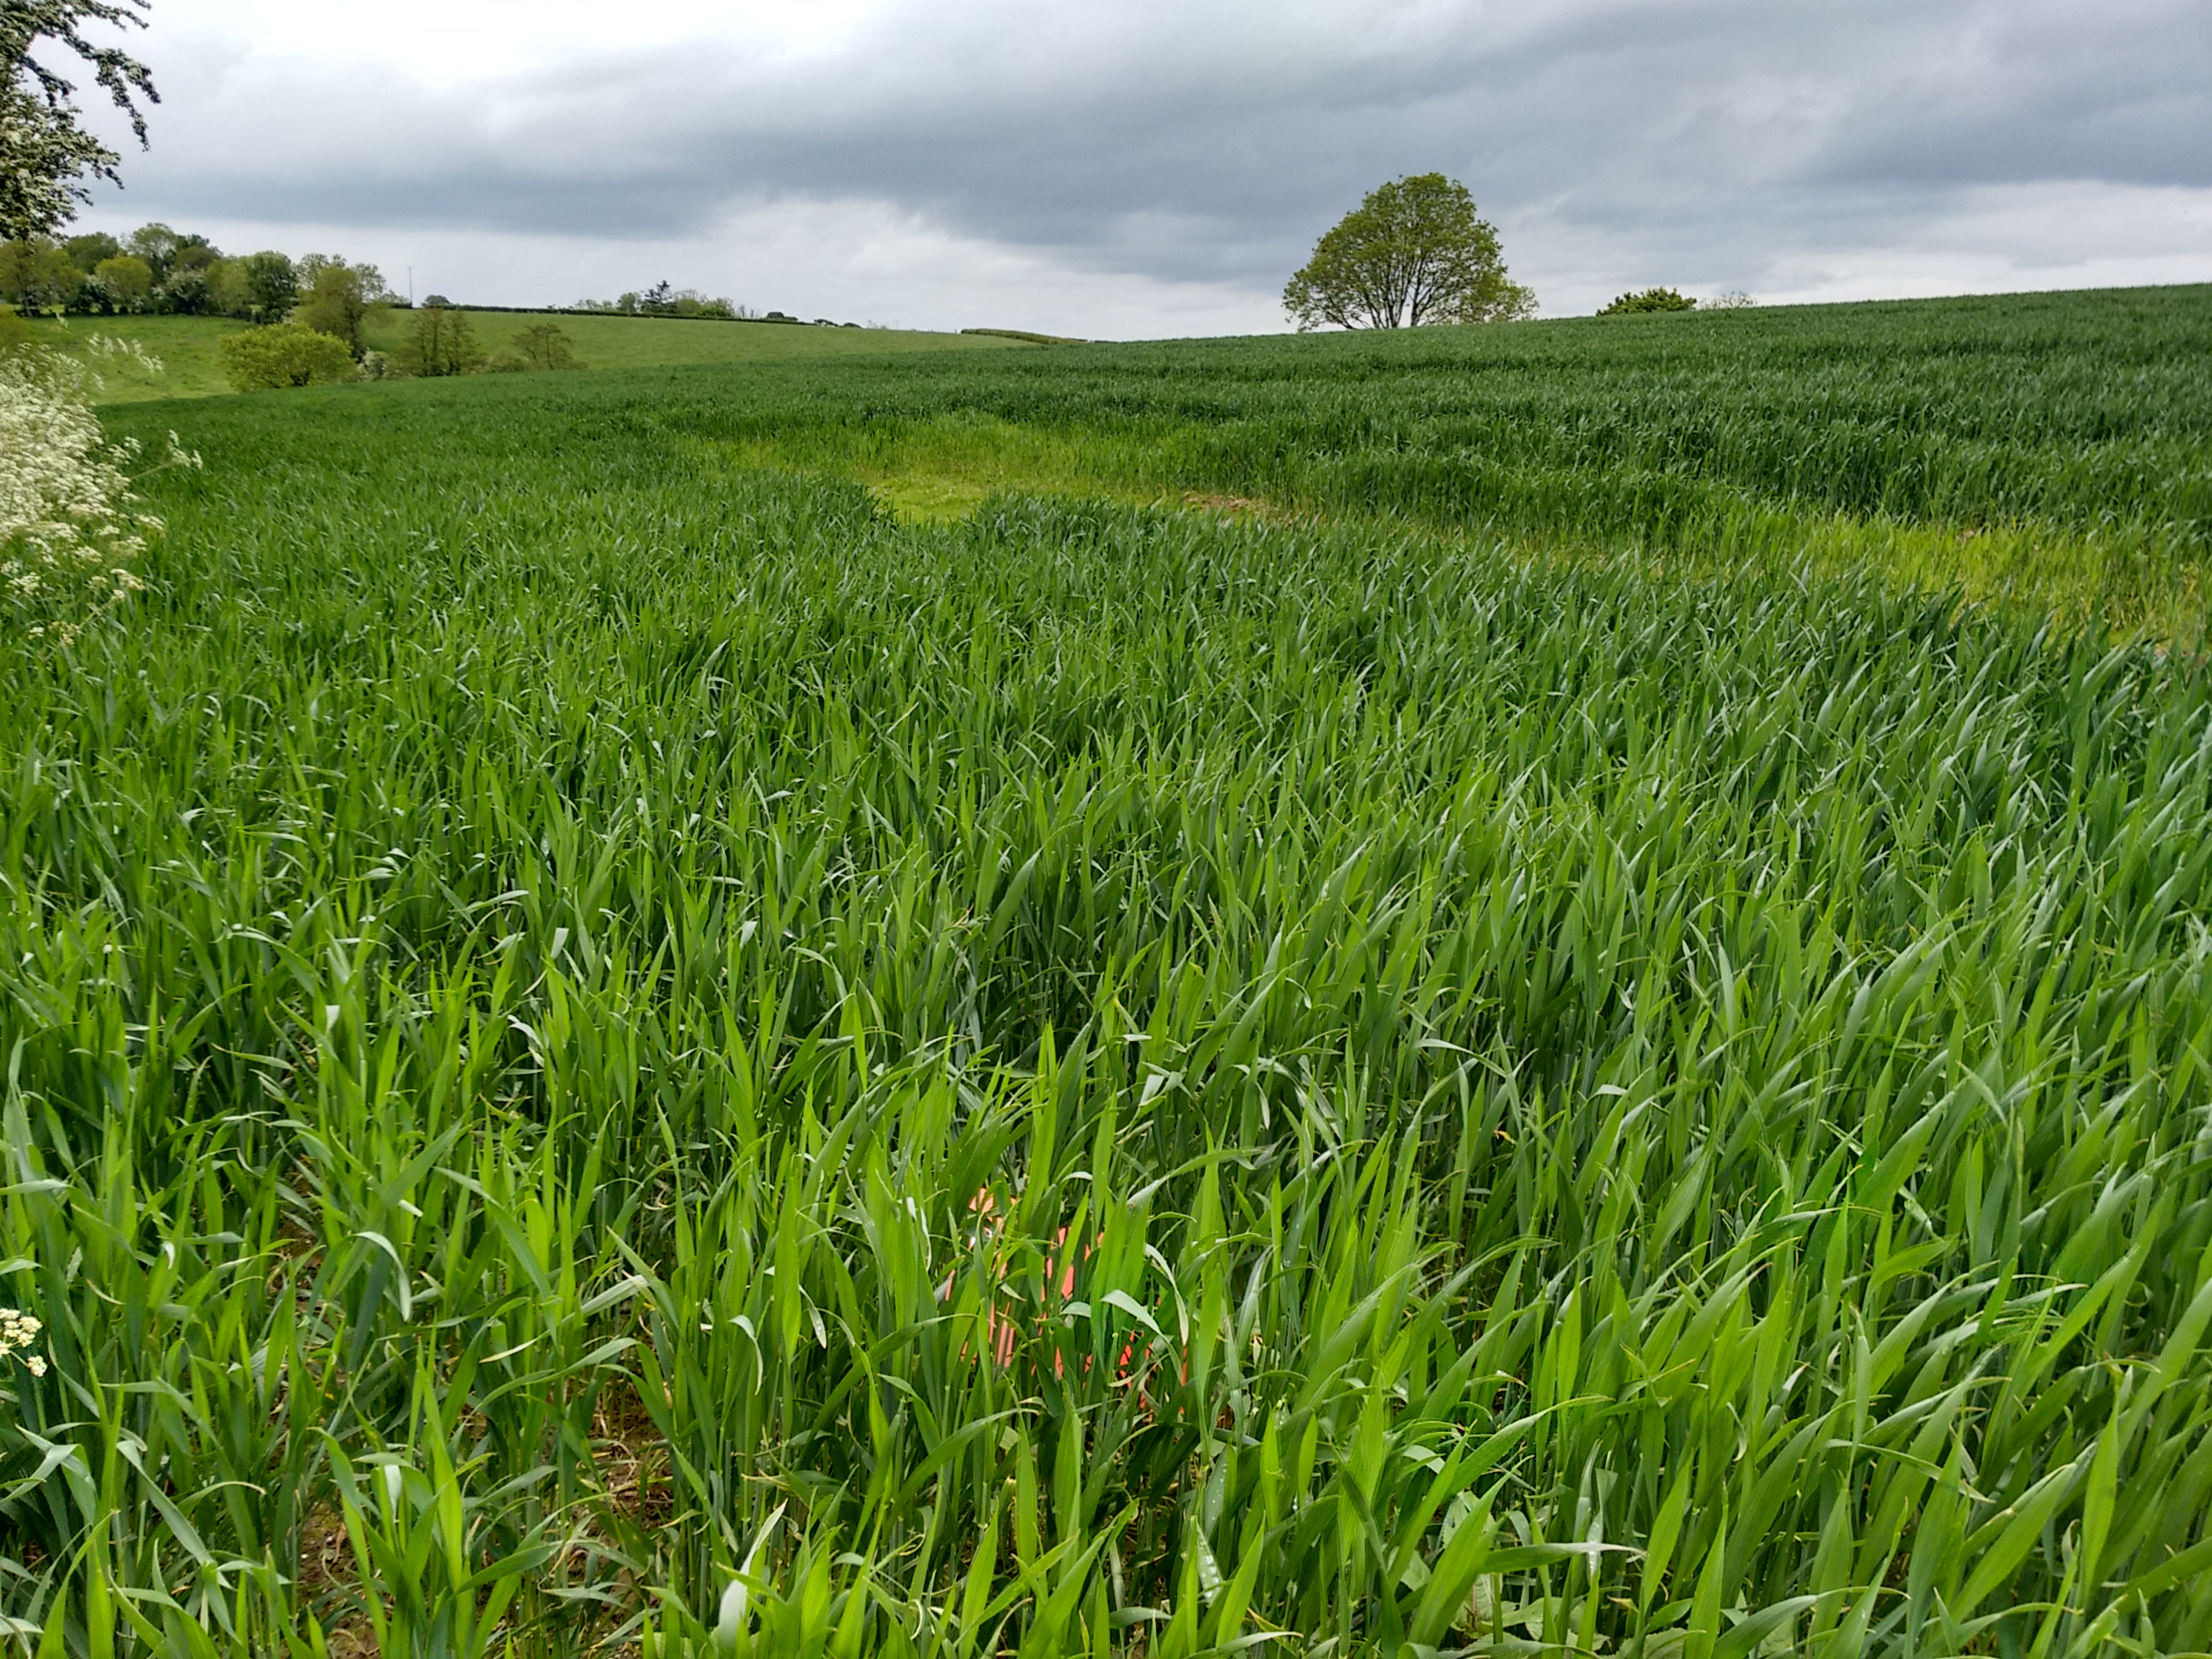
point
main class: Cropland
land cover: Barley
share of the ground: > 75 %
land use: Agriculture (excluding fallow land and kitchen gardens)
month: June
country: GB
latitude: 54.8042
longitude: -7.5011
